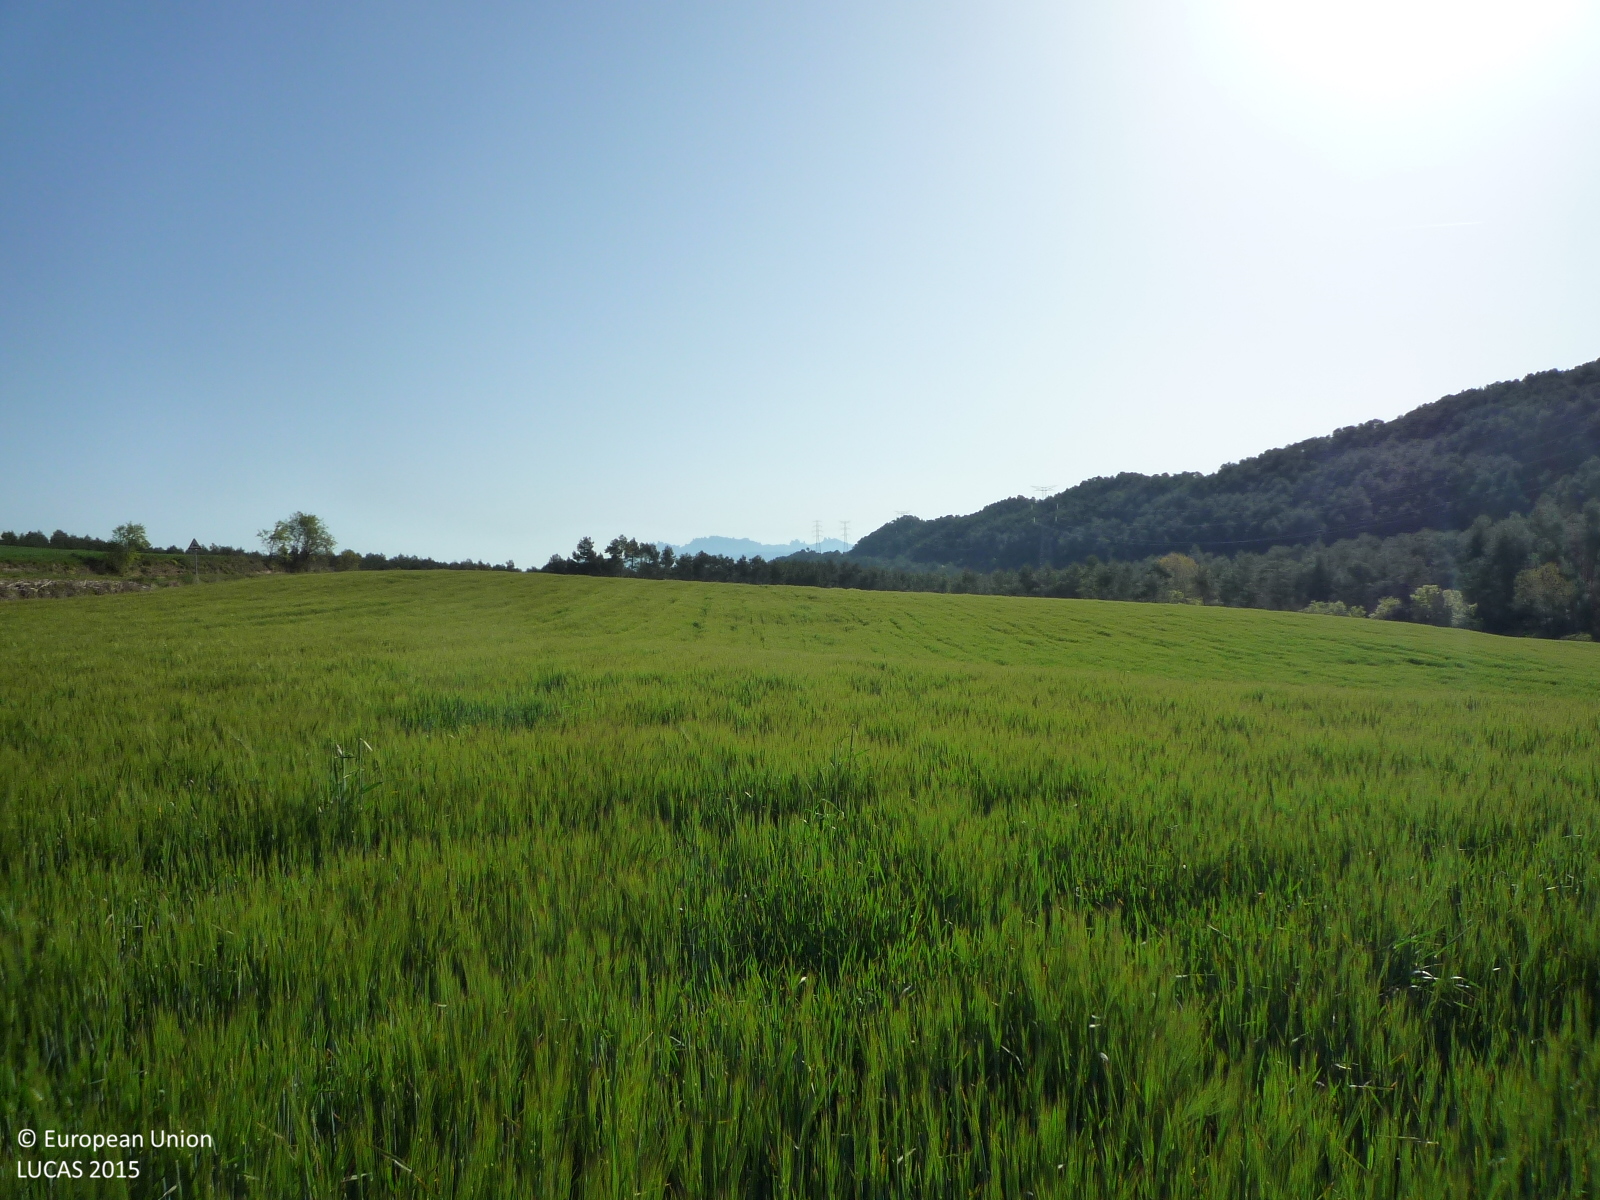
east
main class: Cropland
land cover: Barley
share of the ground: > 75 %
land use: Agriculture (excluding fallow land and kitchen gardens)
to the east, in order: Barley
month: April
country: ES
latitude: 41.5392
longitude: 1.5651
